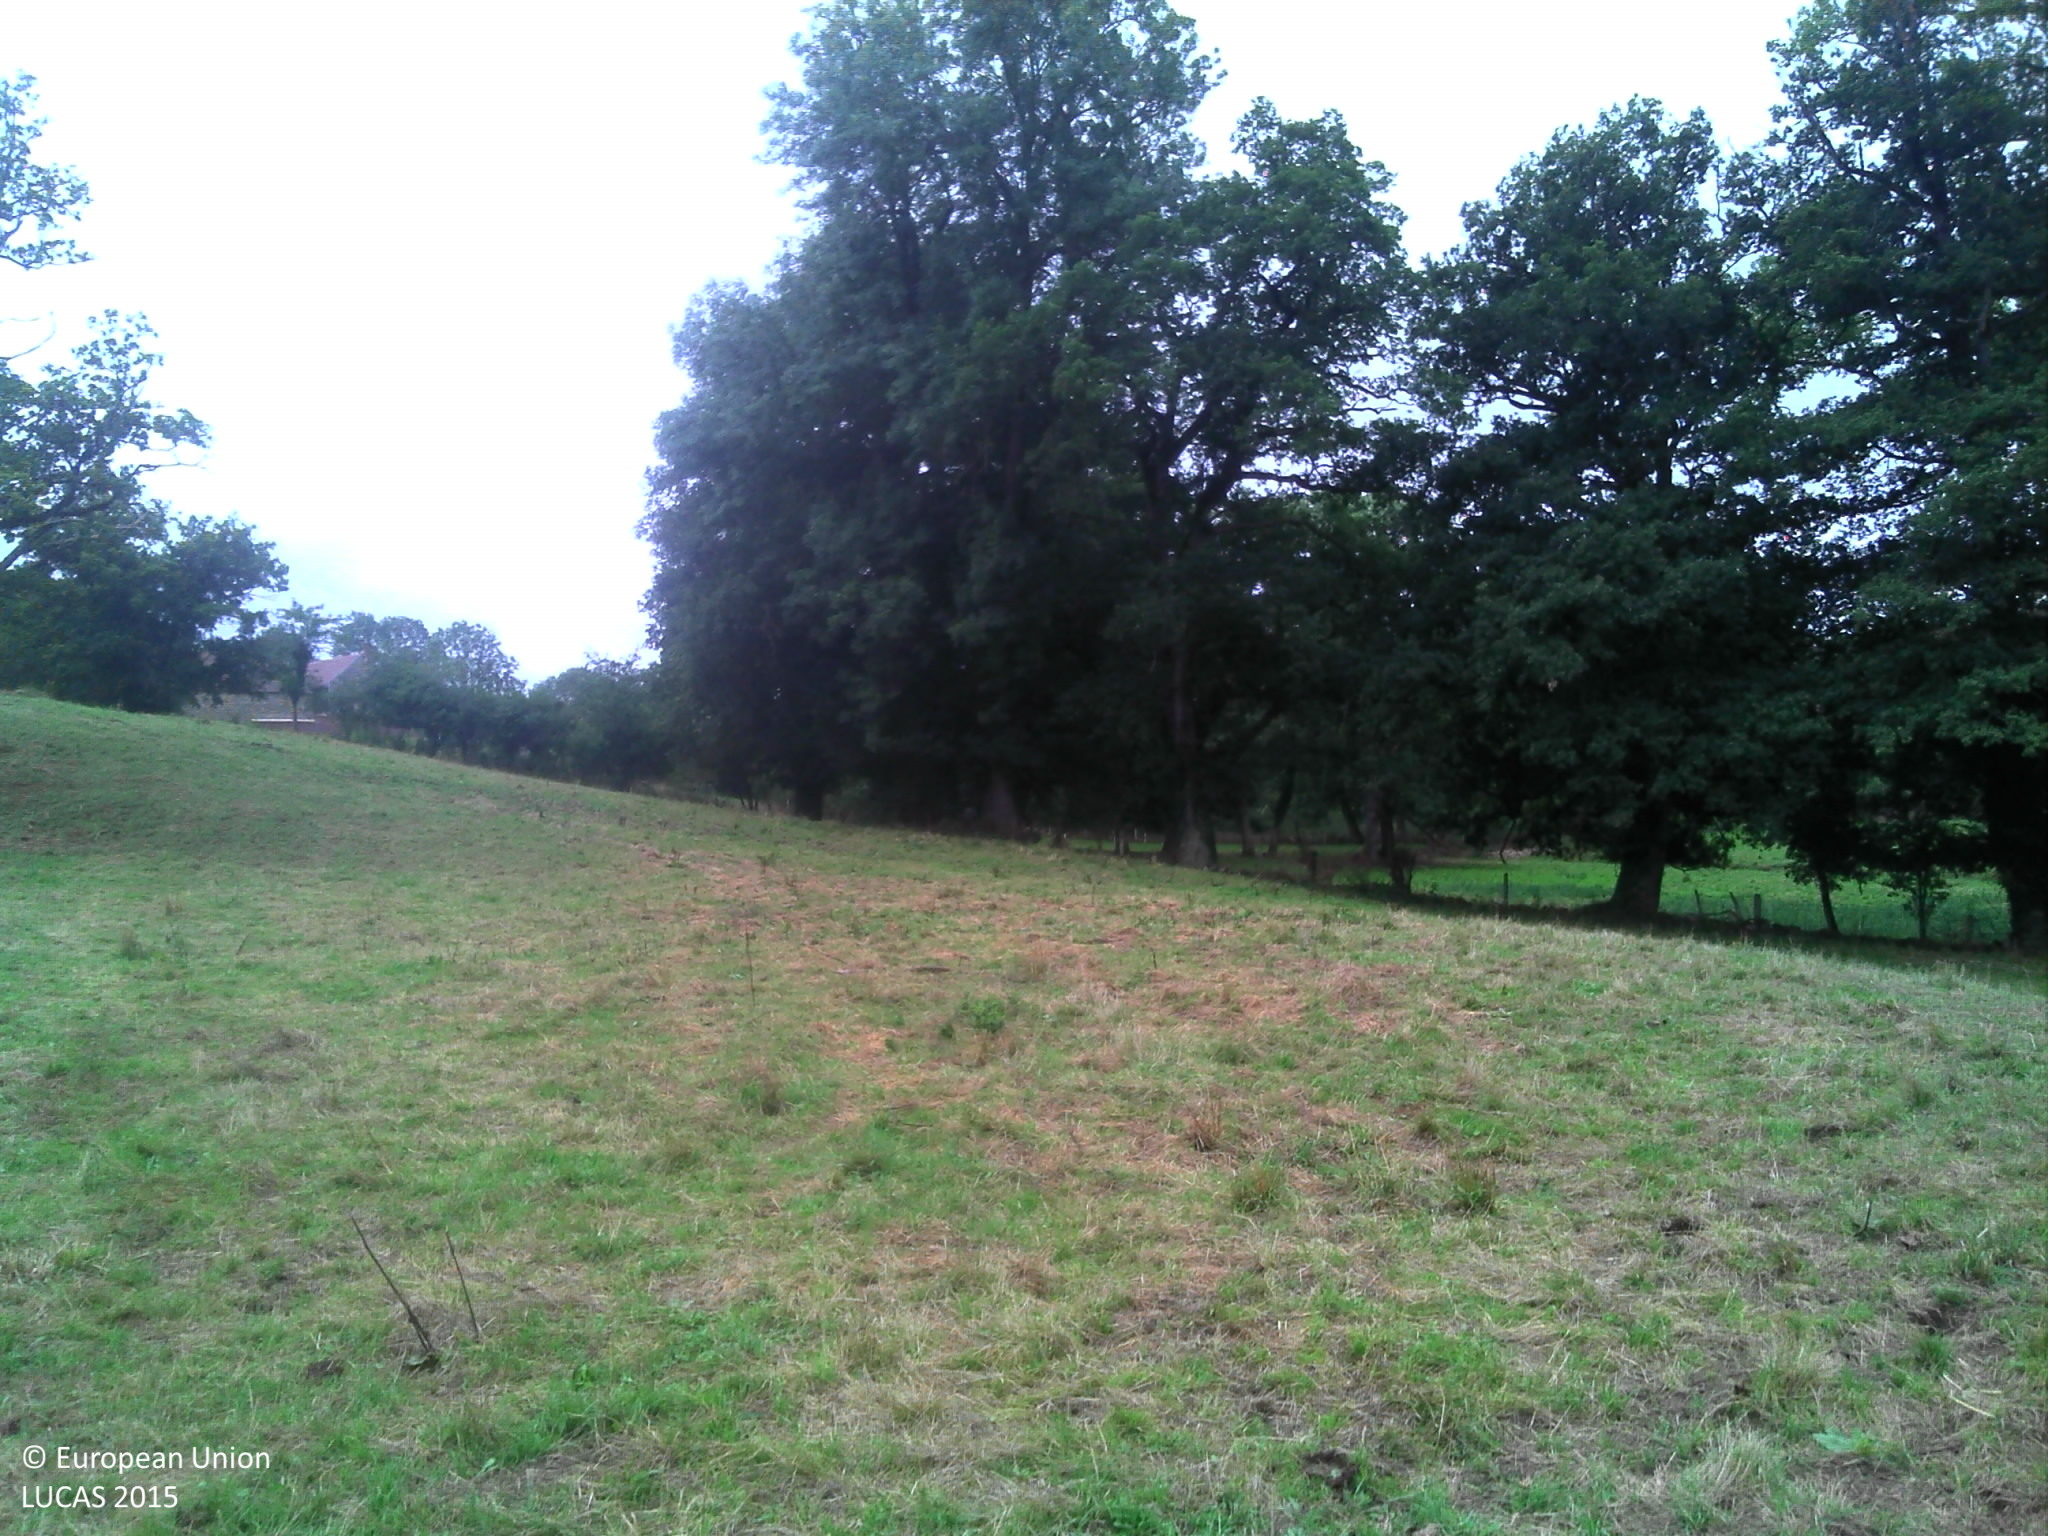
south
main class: Grassland
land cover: Grassland without tree/shrub cover
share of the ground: > 75 %
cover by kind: herbaceous plants 100 %
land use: Agriculture (excluding fallow land and kitchen gardens)
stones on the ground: < 10 %
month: August
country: FR
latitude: 46.0717
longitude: 2.2768
